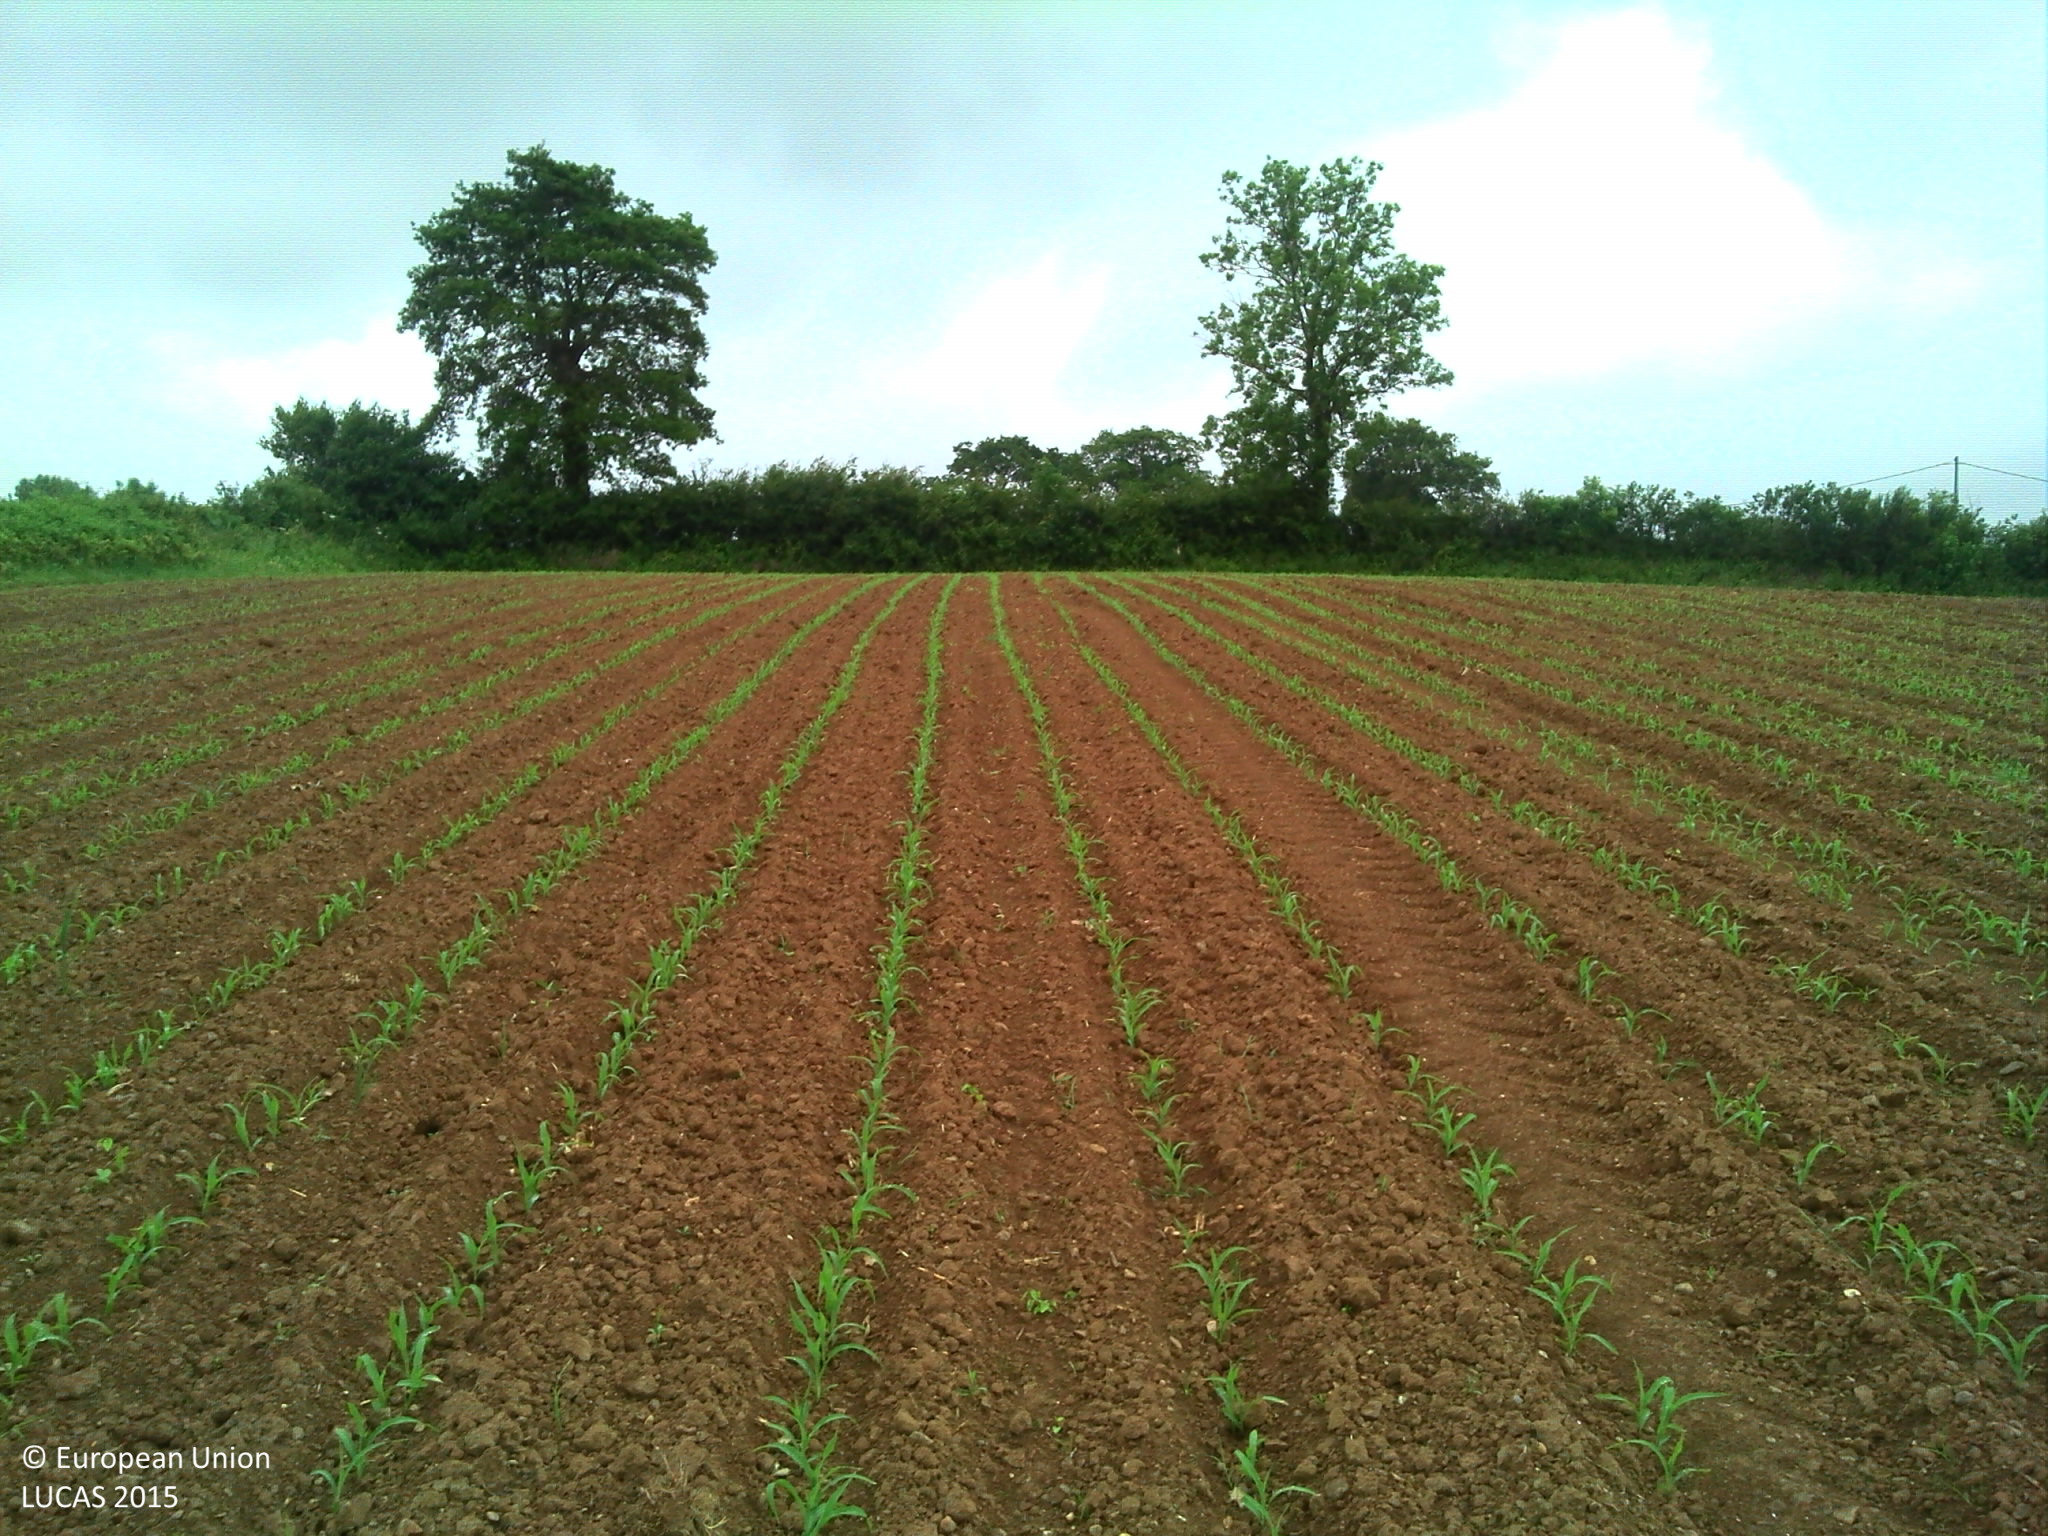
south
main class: Cropland
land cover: Maize
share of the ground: < 10 %
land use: Agriculture (excluding fallow land and kitchen gardens)
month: June
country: FR
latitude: 49.4684
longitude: -1.5446
